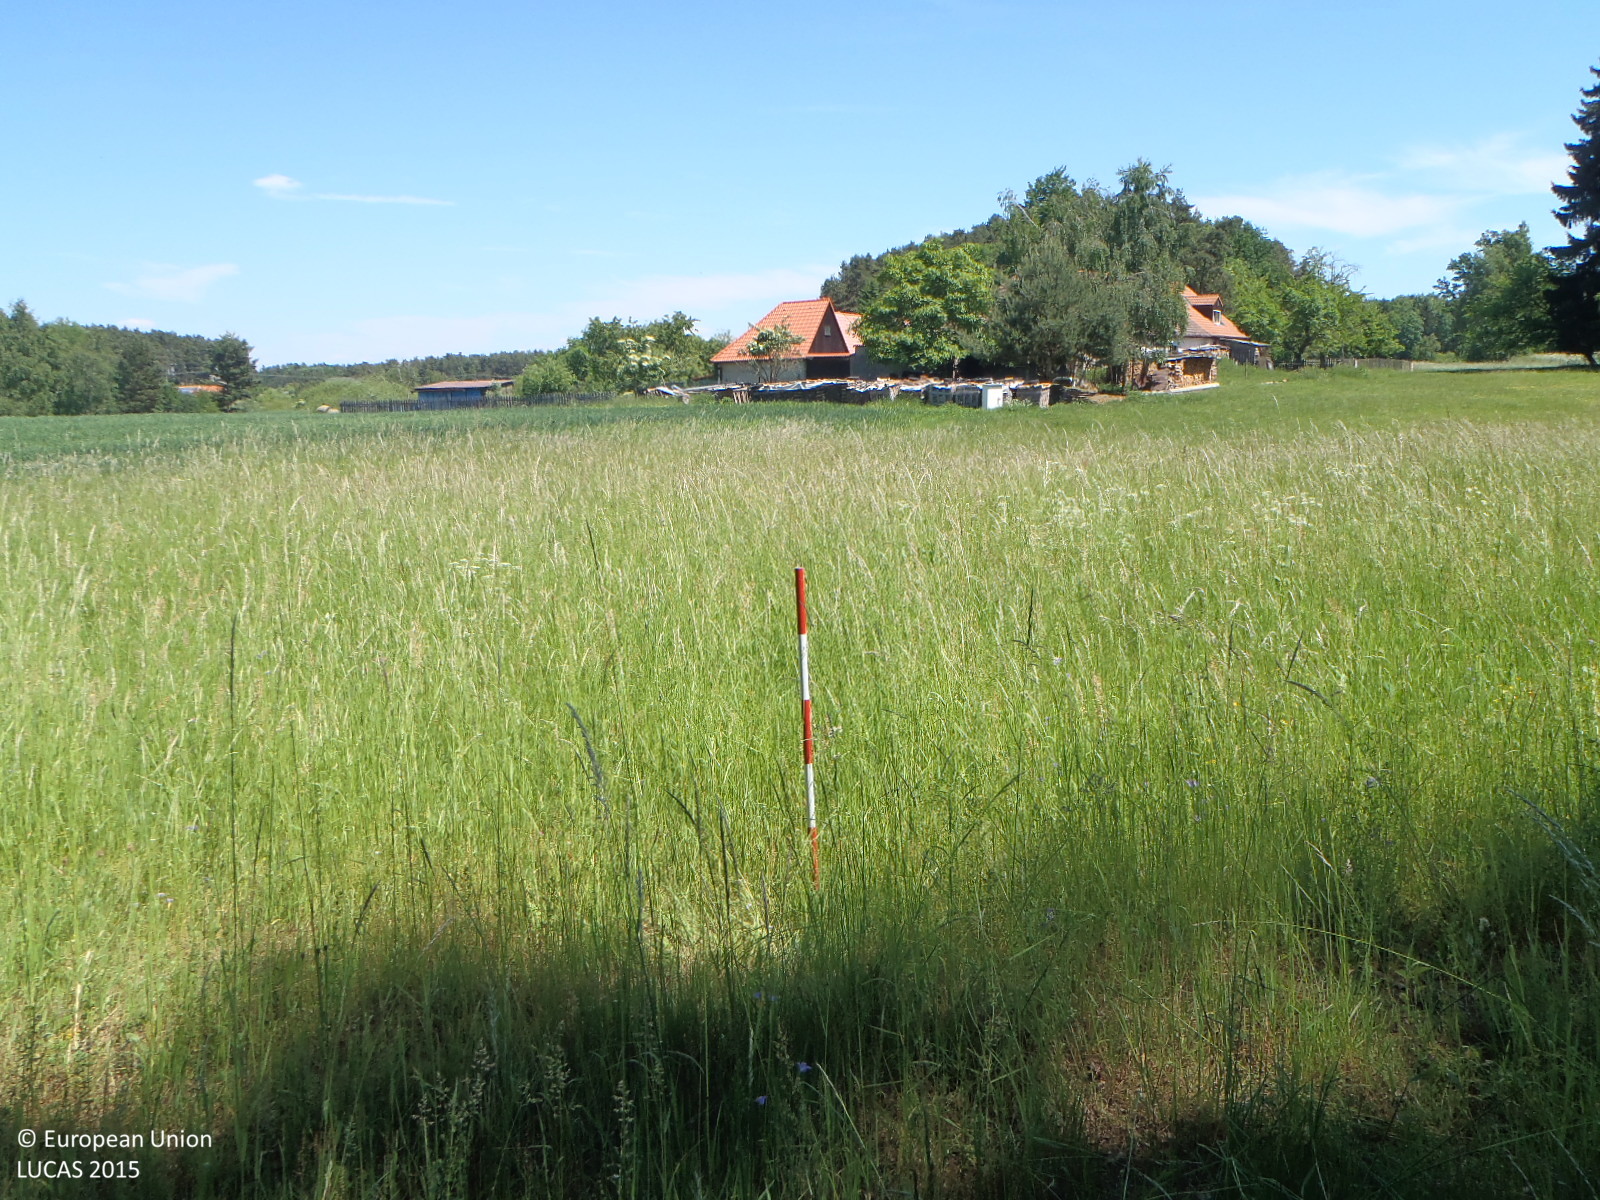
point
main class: Grassland
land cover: Grassland without tree/shrub cover
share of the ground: > 75 %
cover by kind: herbaceous plants 95 %, unconsolidated bare surface 5 %
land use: Agriculture (excluding fallow land and kitchen gardens)
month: June
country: CZ
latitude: 48.9303
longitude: 14.3551
